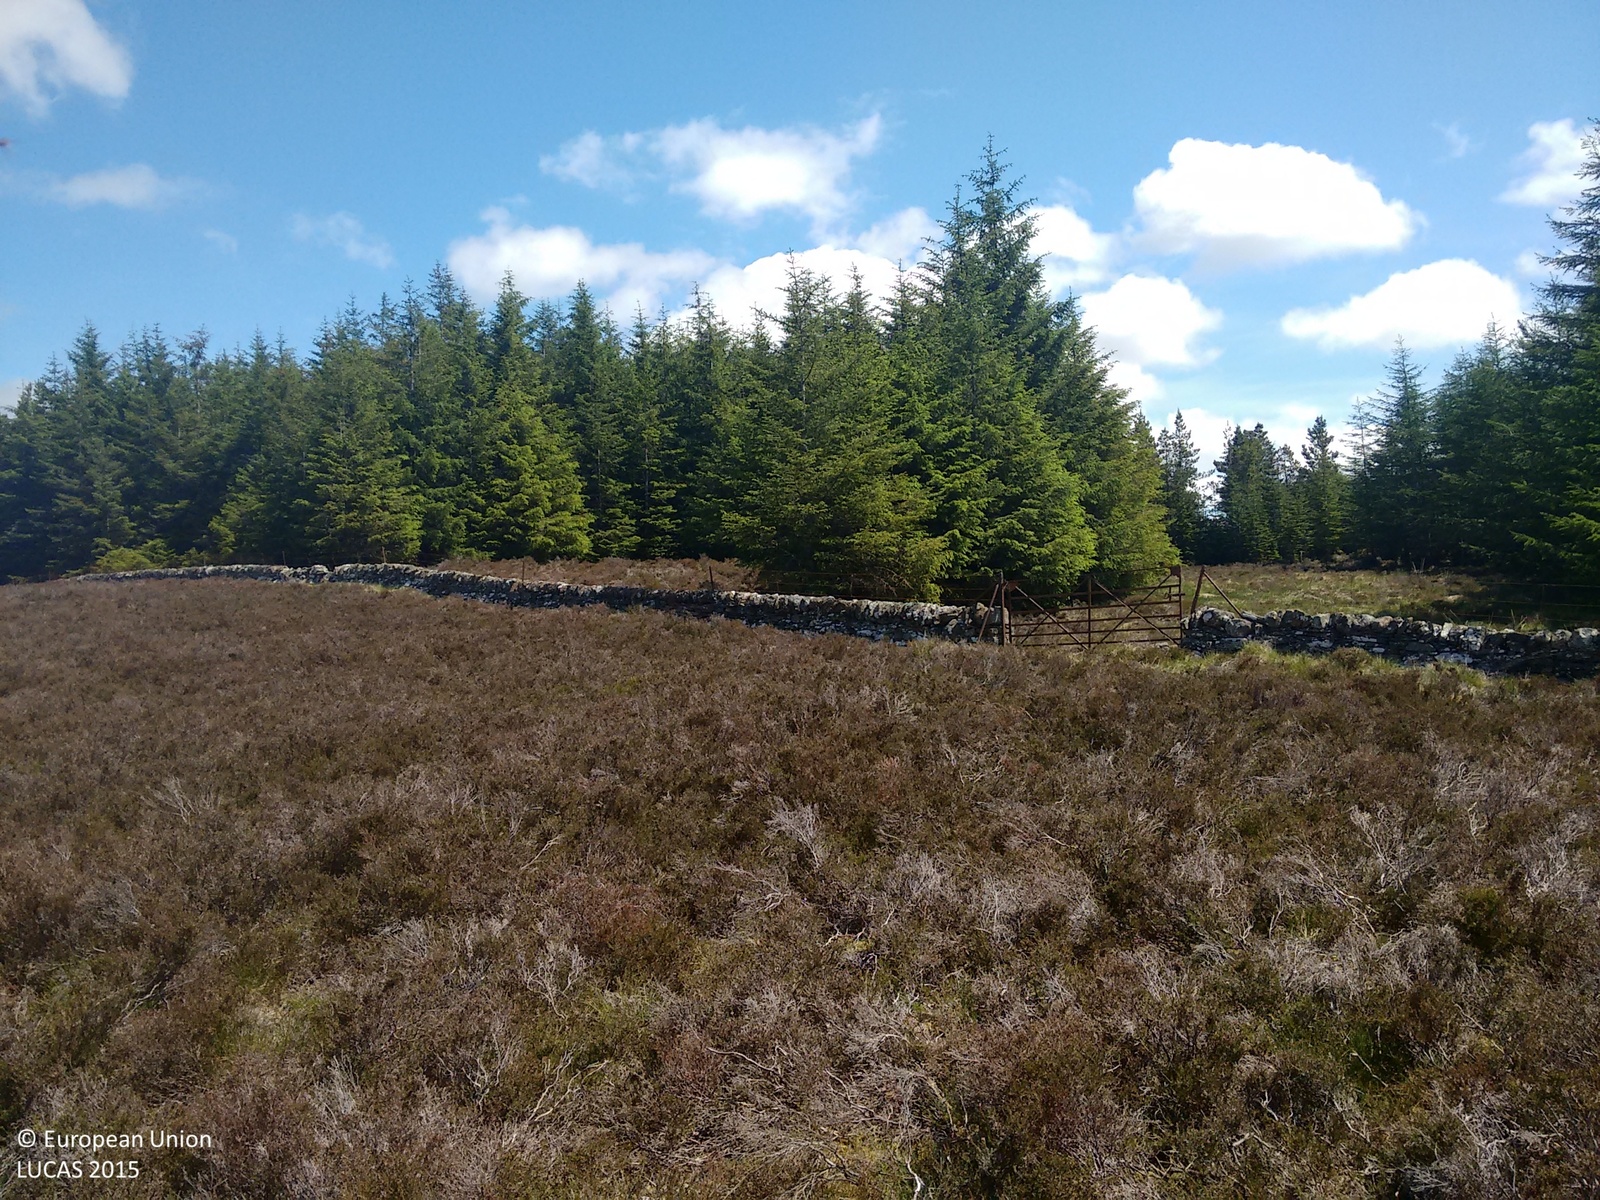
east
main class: Shrubland
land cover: Shrubland without tree cover
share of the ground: > 75 %
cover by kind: shrubs 90 %, herbaceous plants 10 %
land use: Semi-natural and natural areas not in use
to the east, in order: Shrubland without tree cover; Dry stone walls; Pine dominated mixed woodland; Grassland without tree/shrub cover; Pine dominated mixed woodland; Grassland without tree/shrub cover; Spruce dominated coniferous woodland
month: June
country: GB
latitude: 56.6787
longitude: -3.6408
